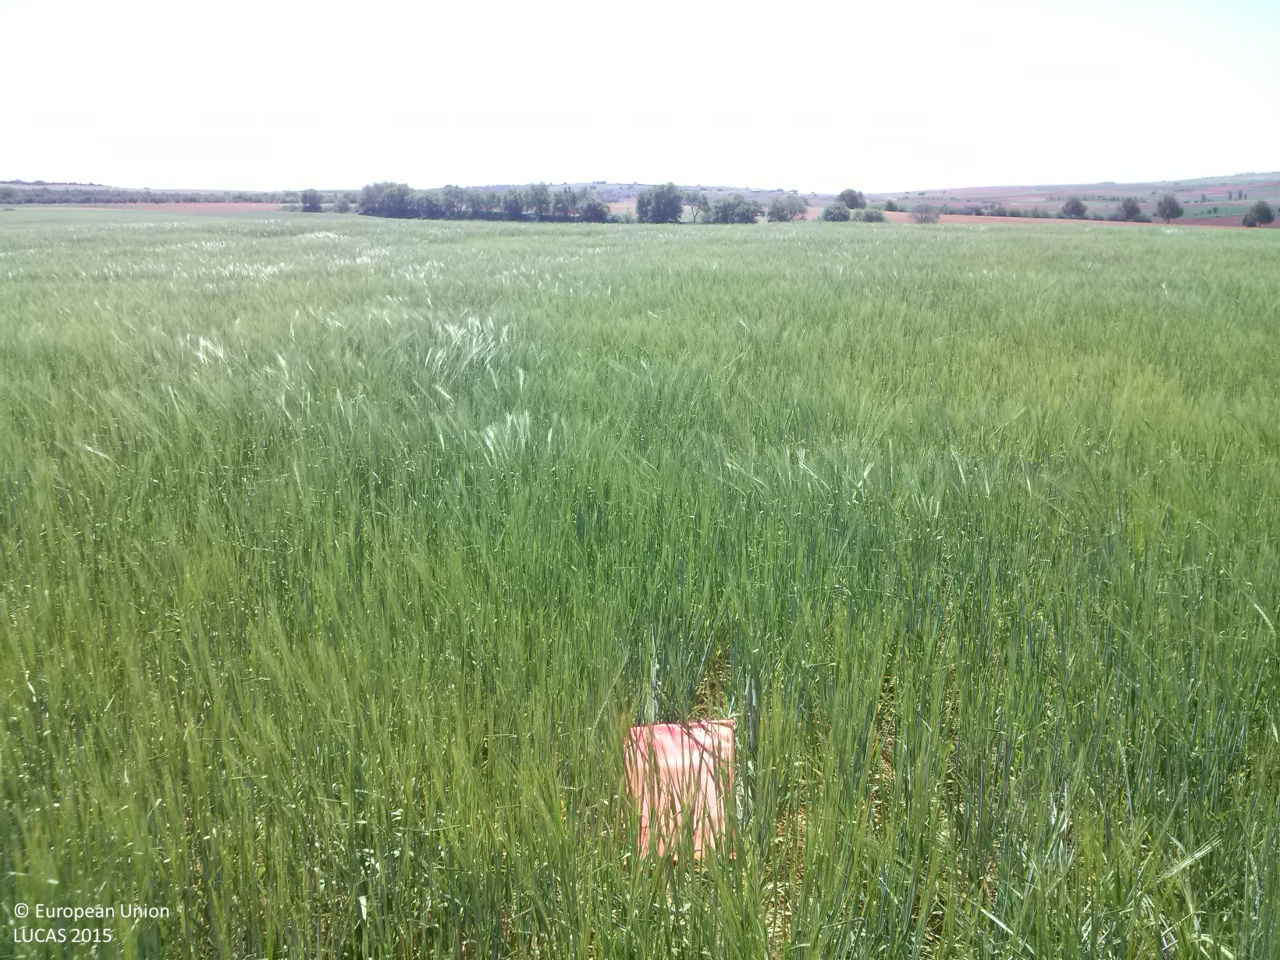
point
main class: Cropland
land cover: Barley
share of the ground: > 75 %
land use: Agriculture (excluding fallow land and kitchen gardens)
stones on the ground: 10 - 25 %
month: May
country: ES
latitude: 39.7933
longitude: -2.7829
